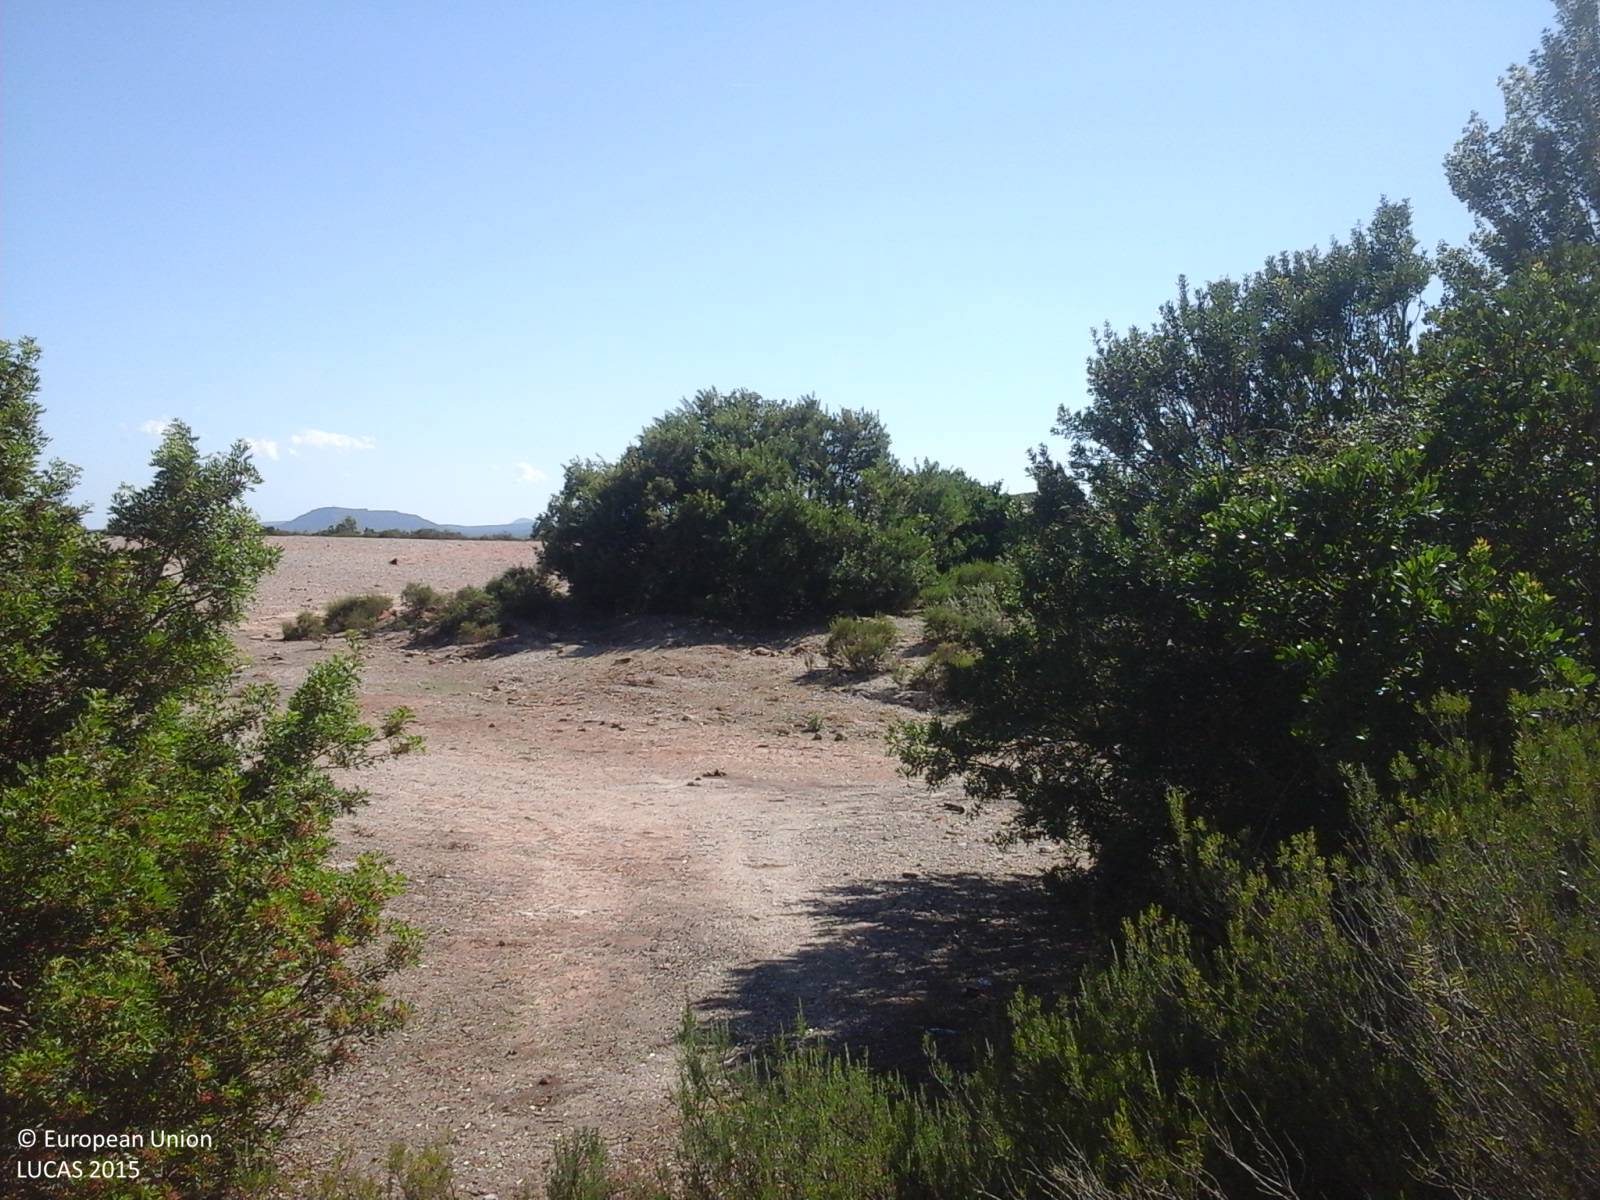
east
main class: Shrubland
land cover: Shrubland with sparse tree cover
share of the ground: > 75 %
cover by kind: shrubs 80 %, herbaceous plants 10 %, broadleaved forest trees 5 %, unconsolidated bare surface 5 %
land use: Agriculture (excluding fallow land and kitchen gardens)
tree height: > 5 m
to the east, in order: Shrubland with sparse tree cover; Tracks; Broadleaved woodland
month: August
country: IT
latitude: 39.6684
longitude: 9.4785
